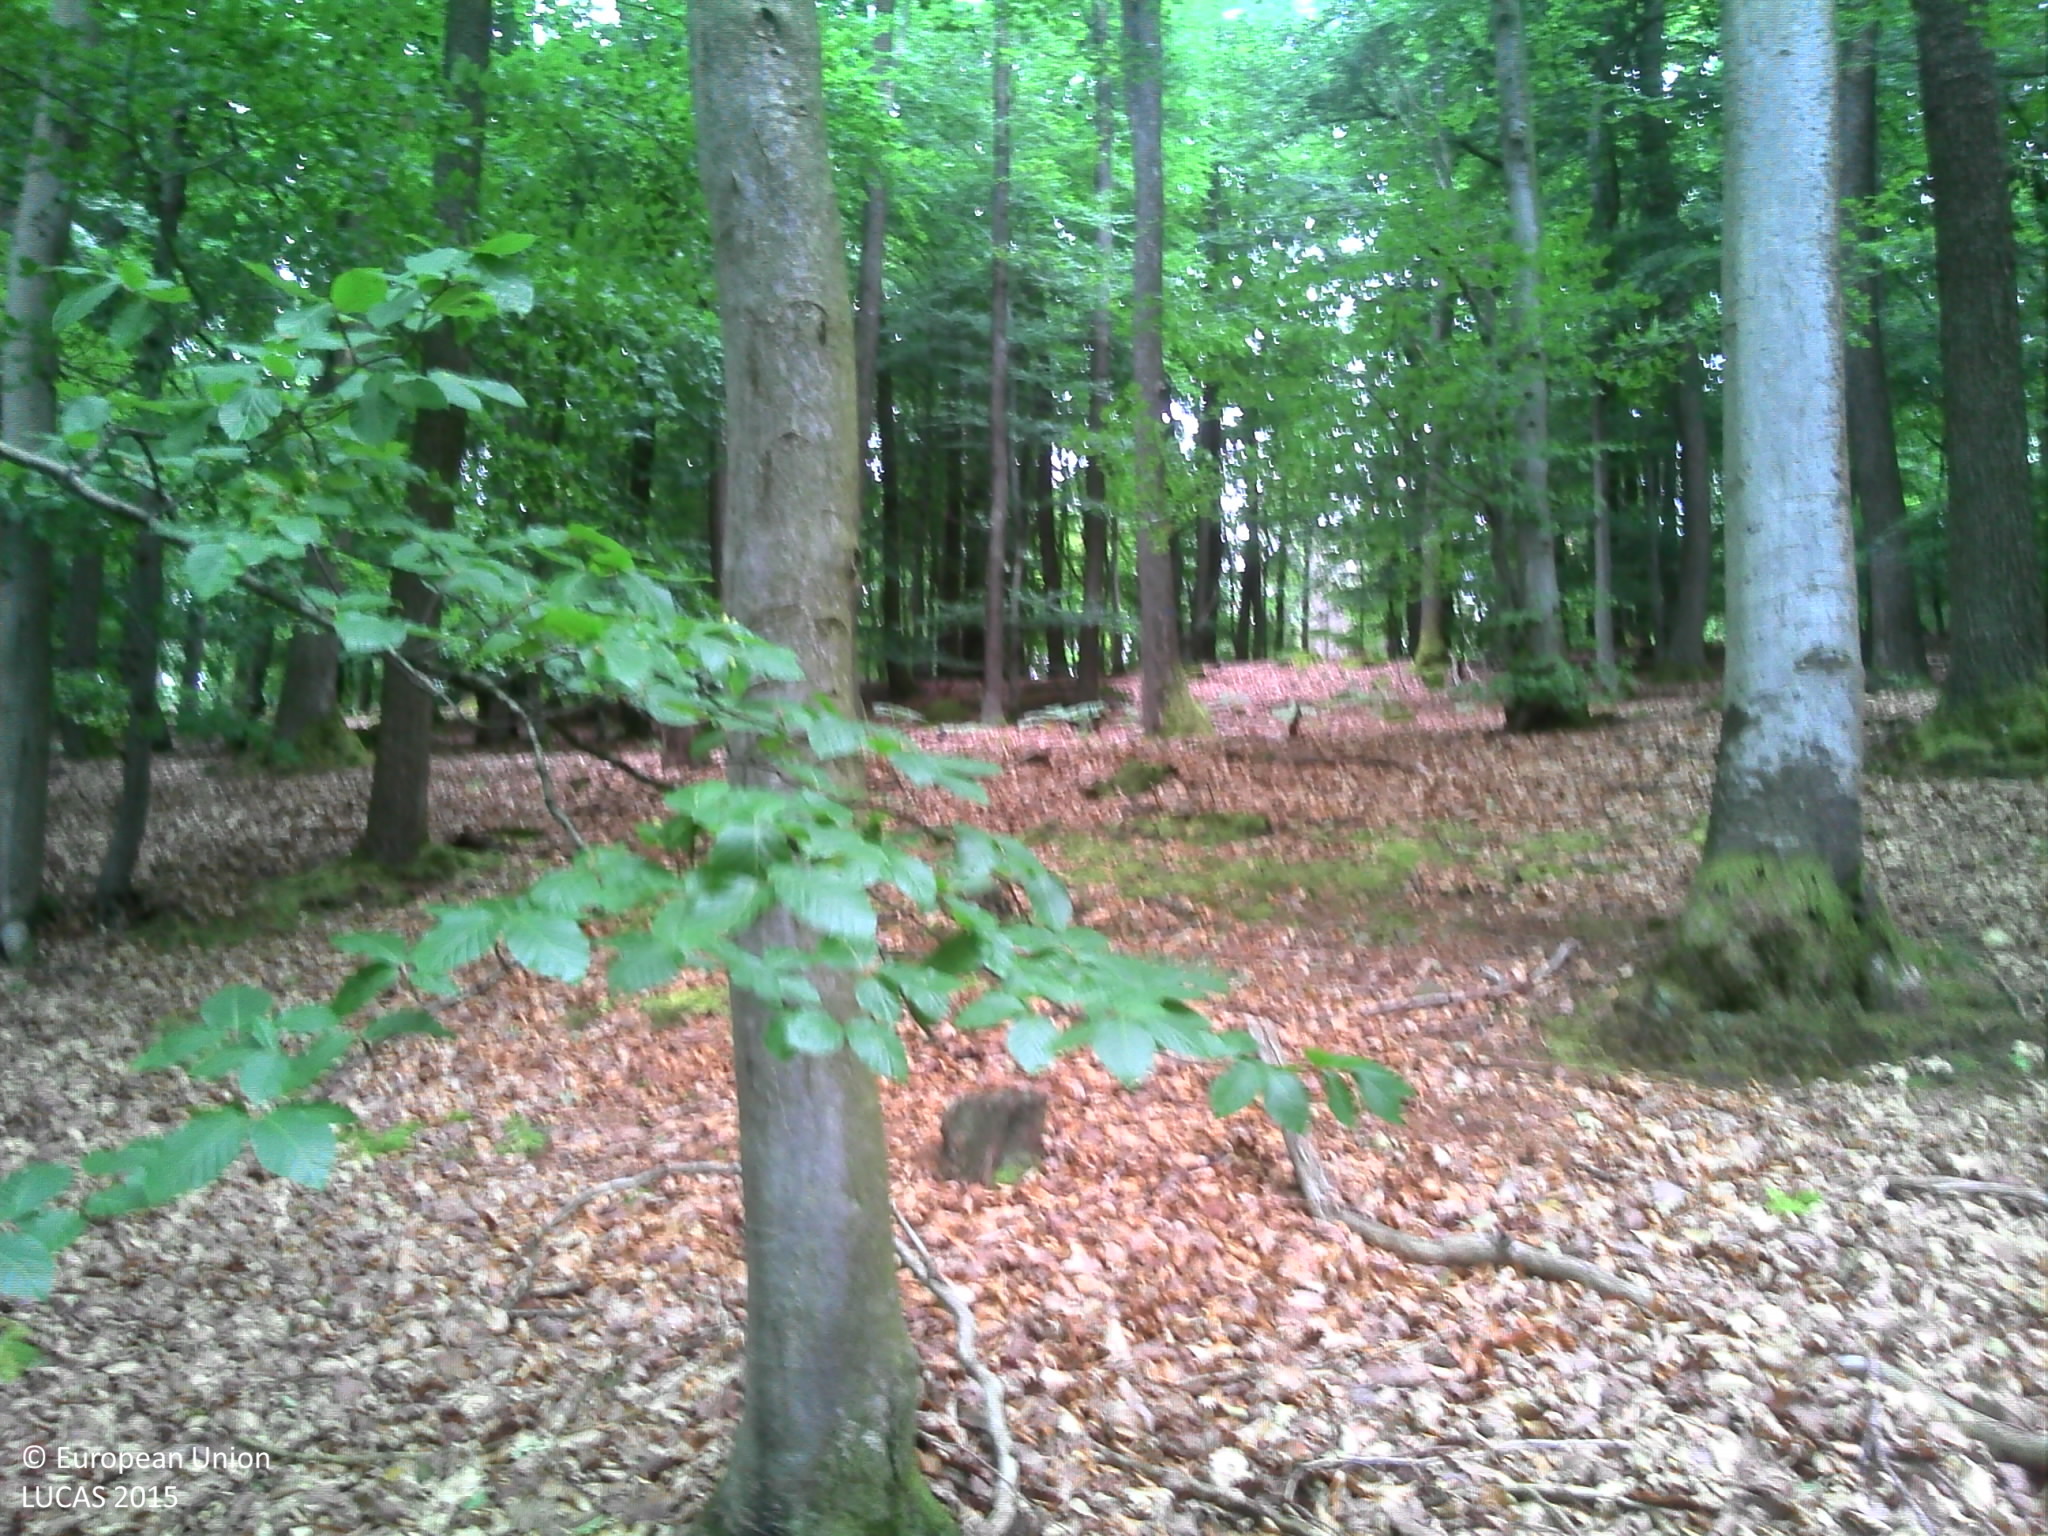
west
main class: Woodland
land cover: Broadleaved woodland
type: beech forest
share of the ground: > 75 %
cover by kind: broadleaved forest trees 100 %
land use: Forestry
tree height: > 5 m
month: July
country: FR
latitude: 48.9537
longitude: 7.6108
